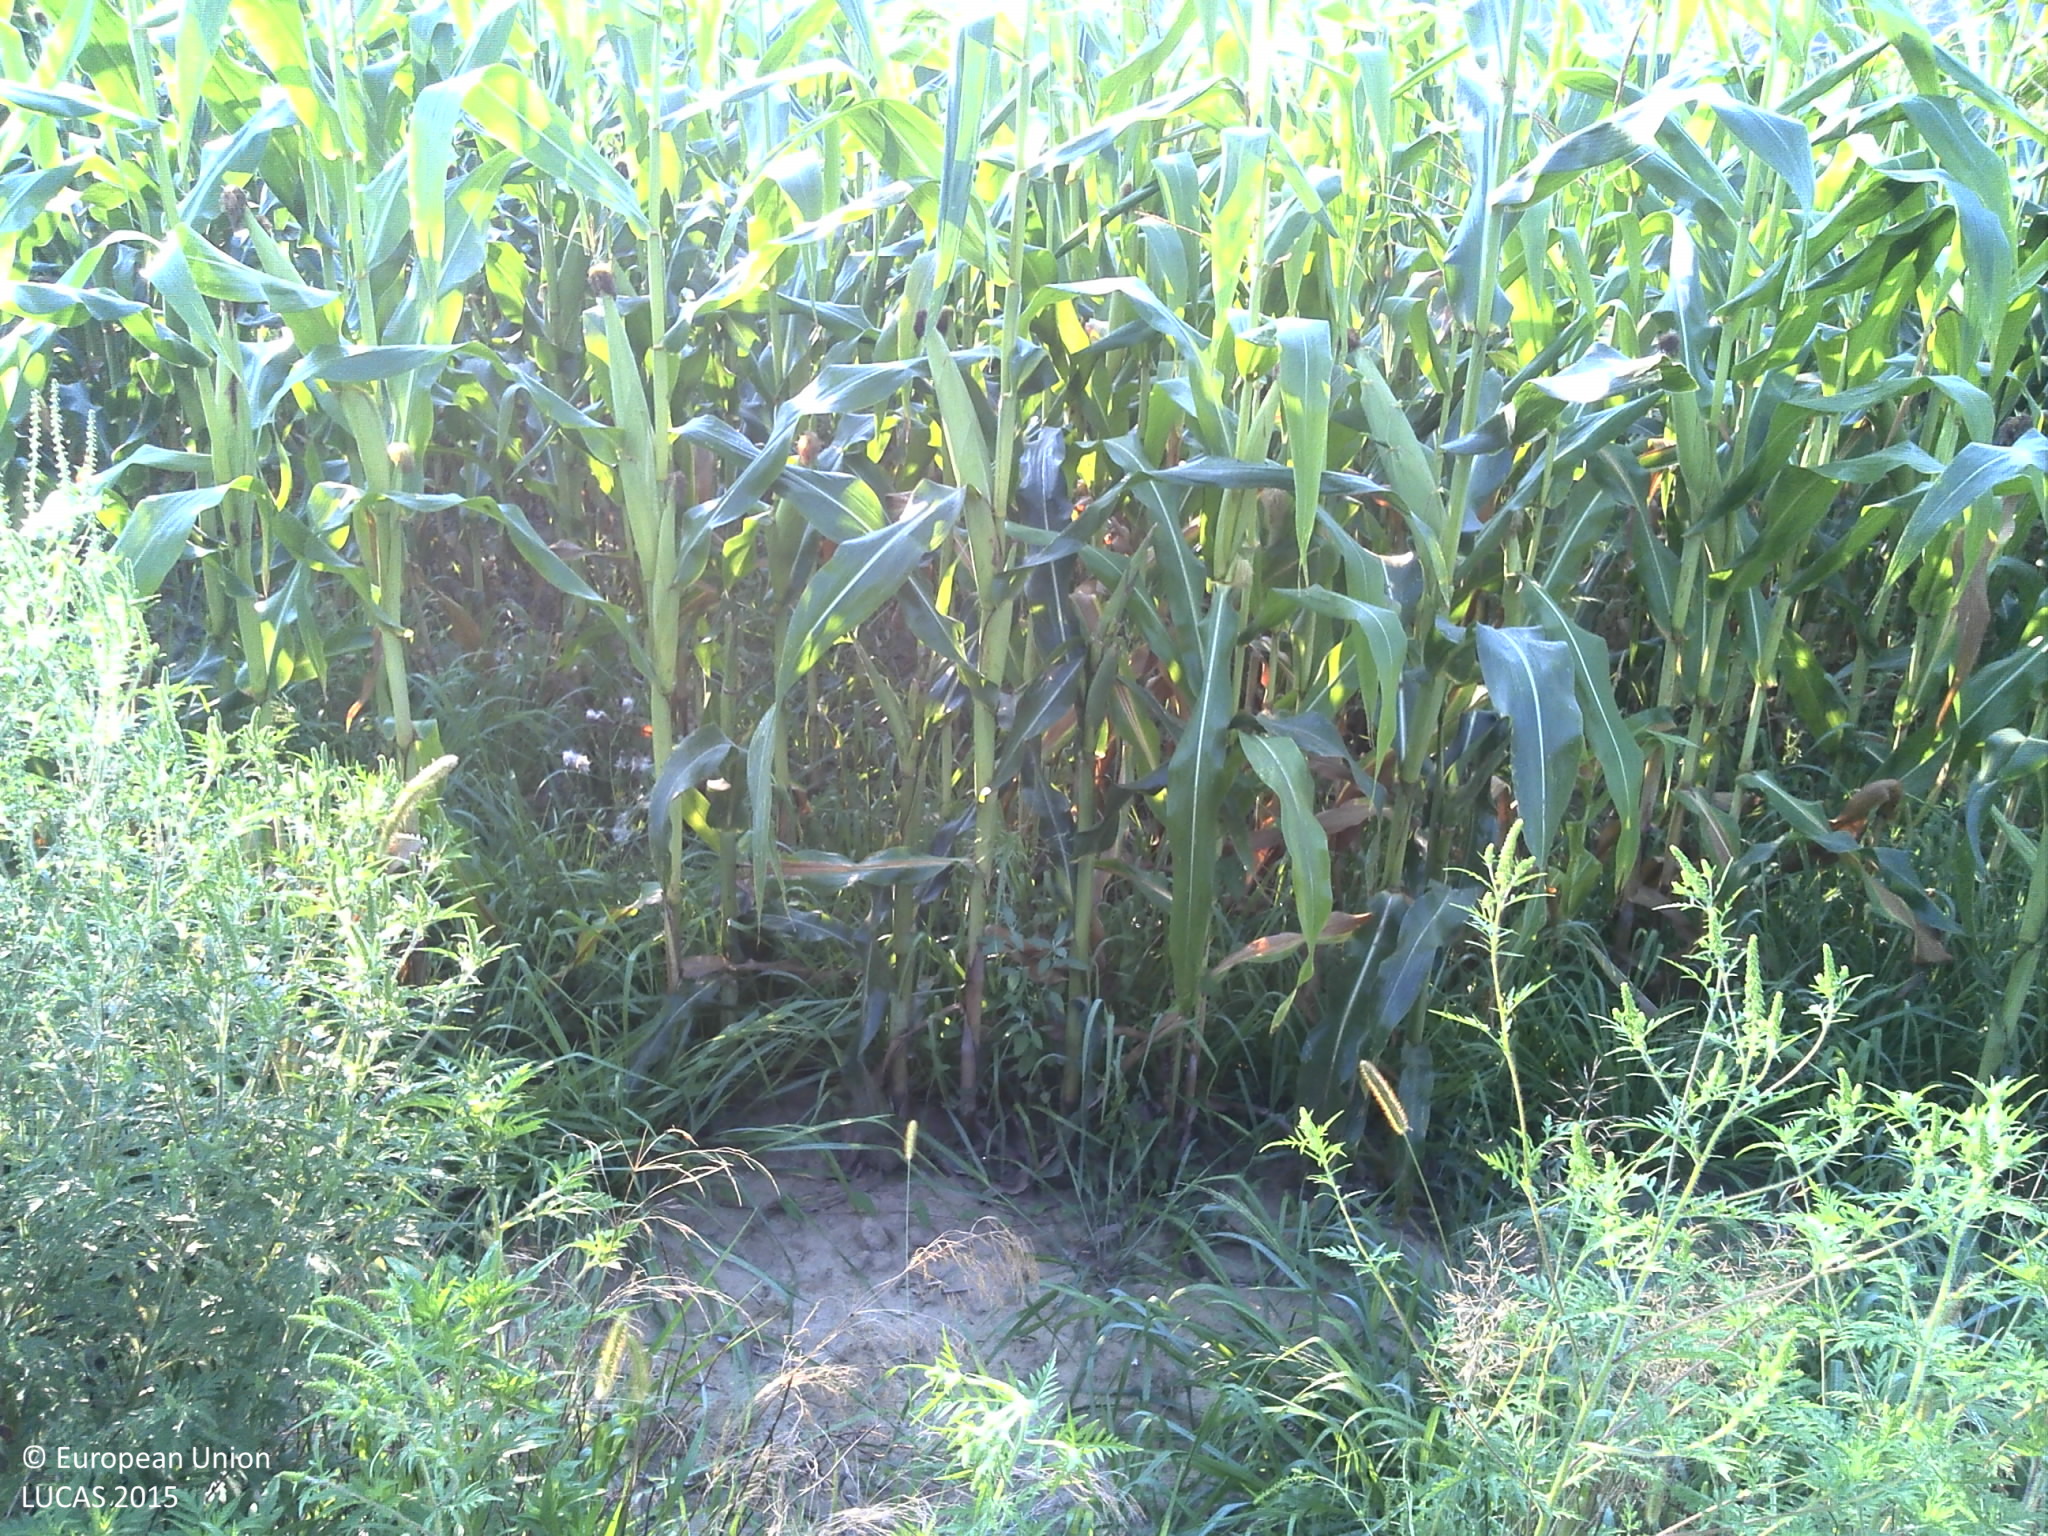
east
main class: Cropland
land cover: Maize
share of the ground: > 75 %
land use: Agriculture (excluding fallow land and kitchen gardens)
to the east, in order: Maize; Common wheat; Shrubland with sparse tree cover
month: August
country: HR
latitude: 45.6690
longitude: 17.2793
